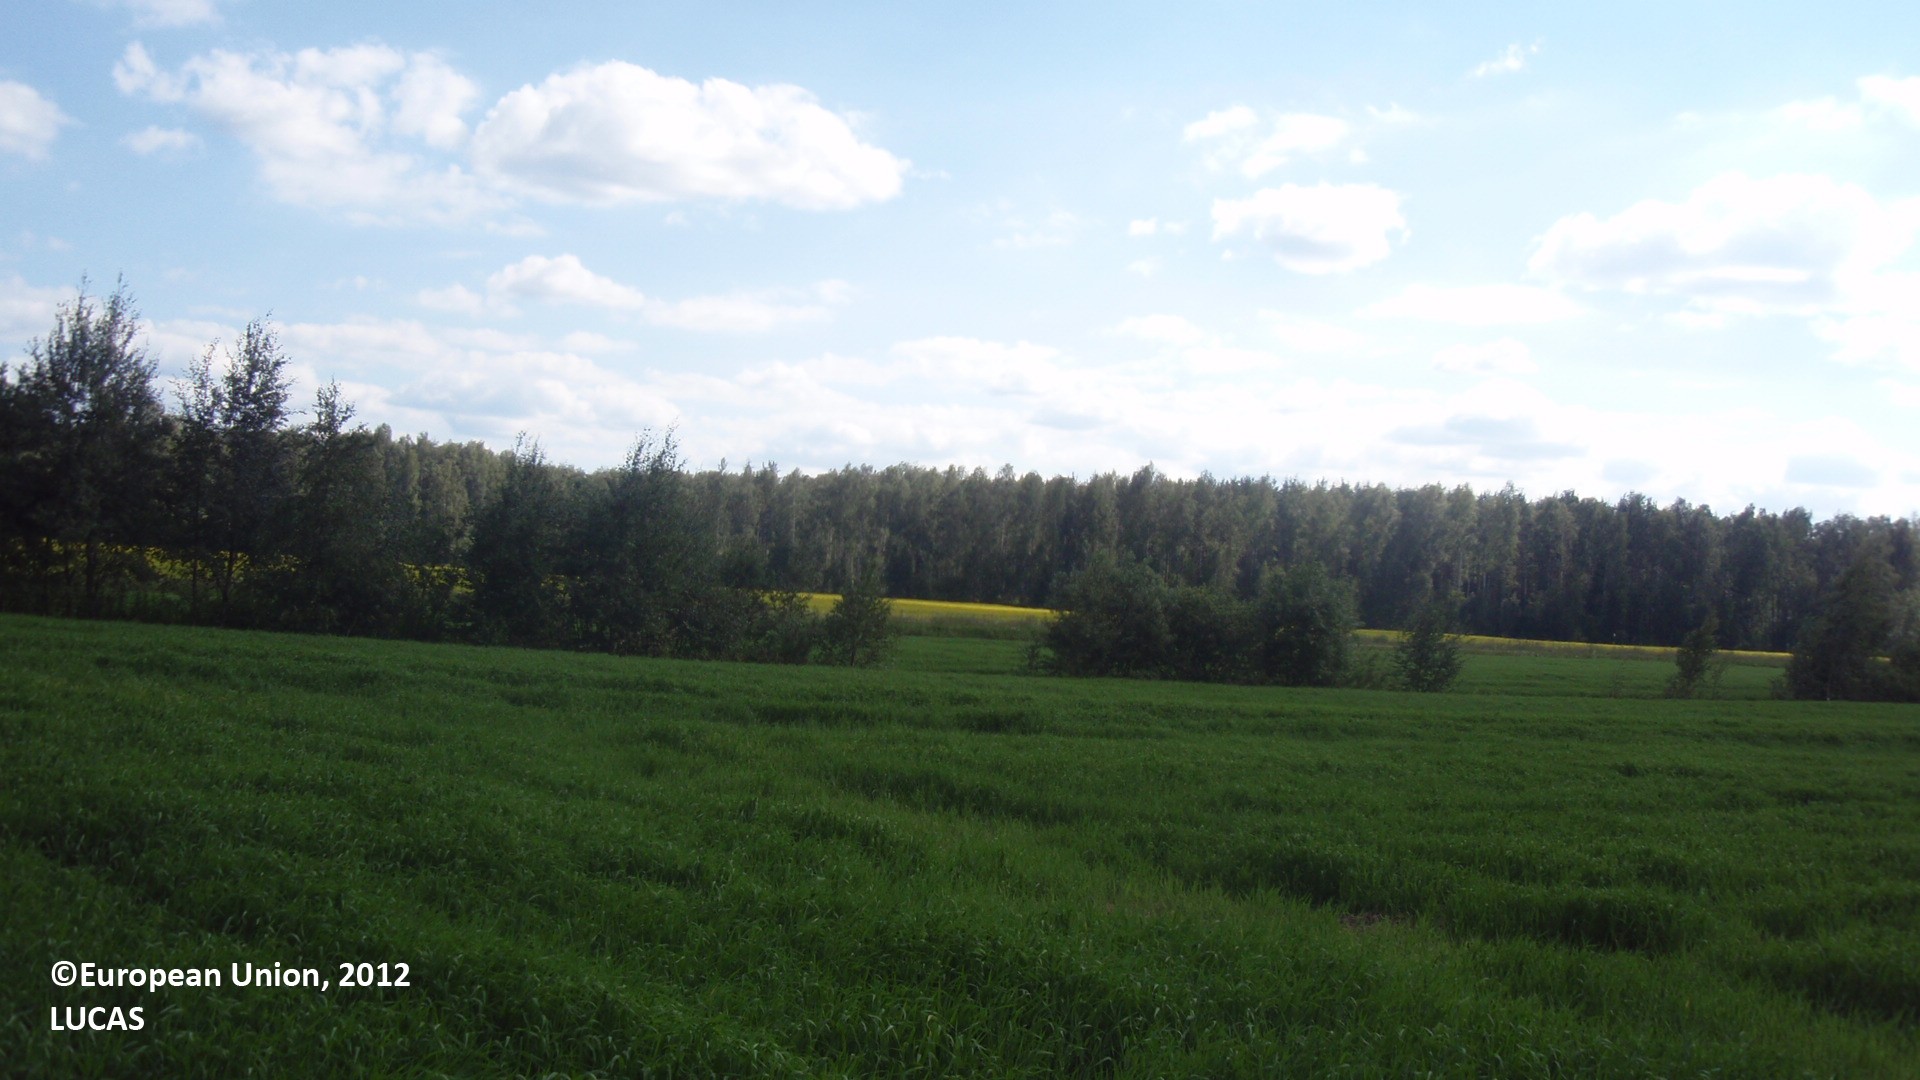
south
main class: Cropland
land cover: Barley
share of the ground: > 75 %
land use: Agriculture (excluding fallow land and kitchen gardens)
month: July
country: FI
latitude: 61.5208
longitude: 29.6381
